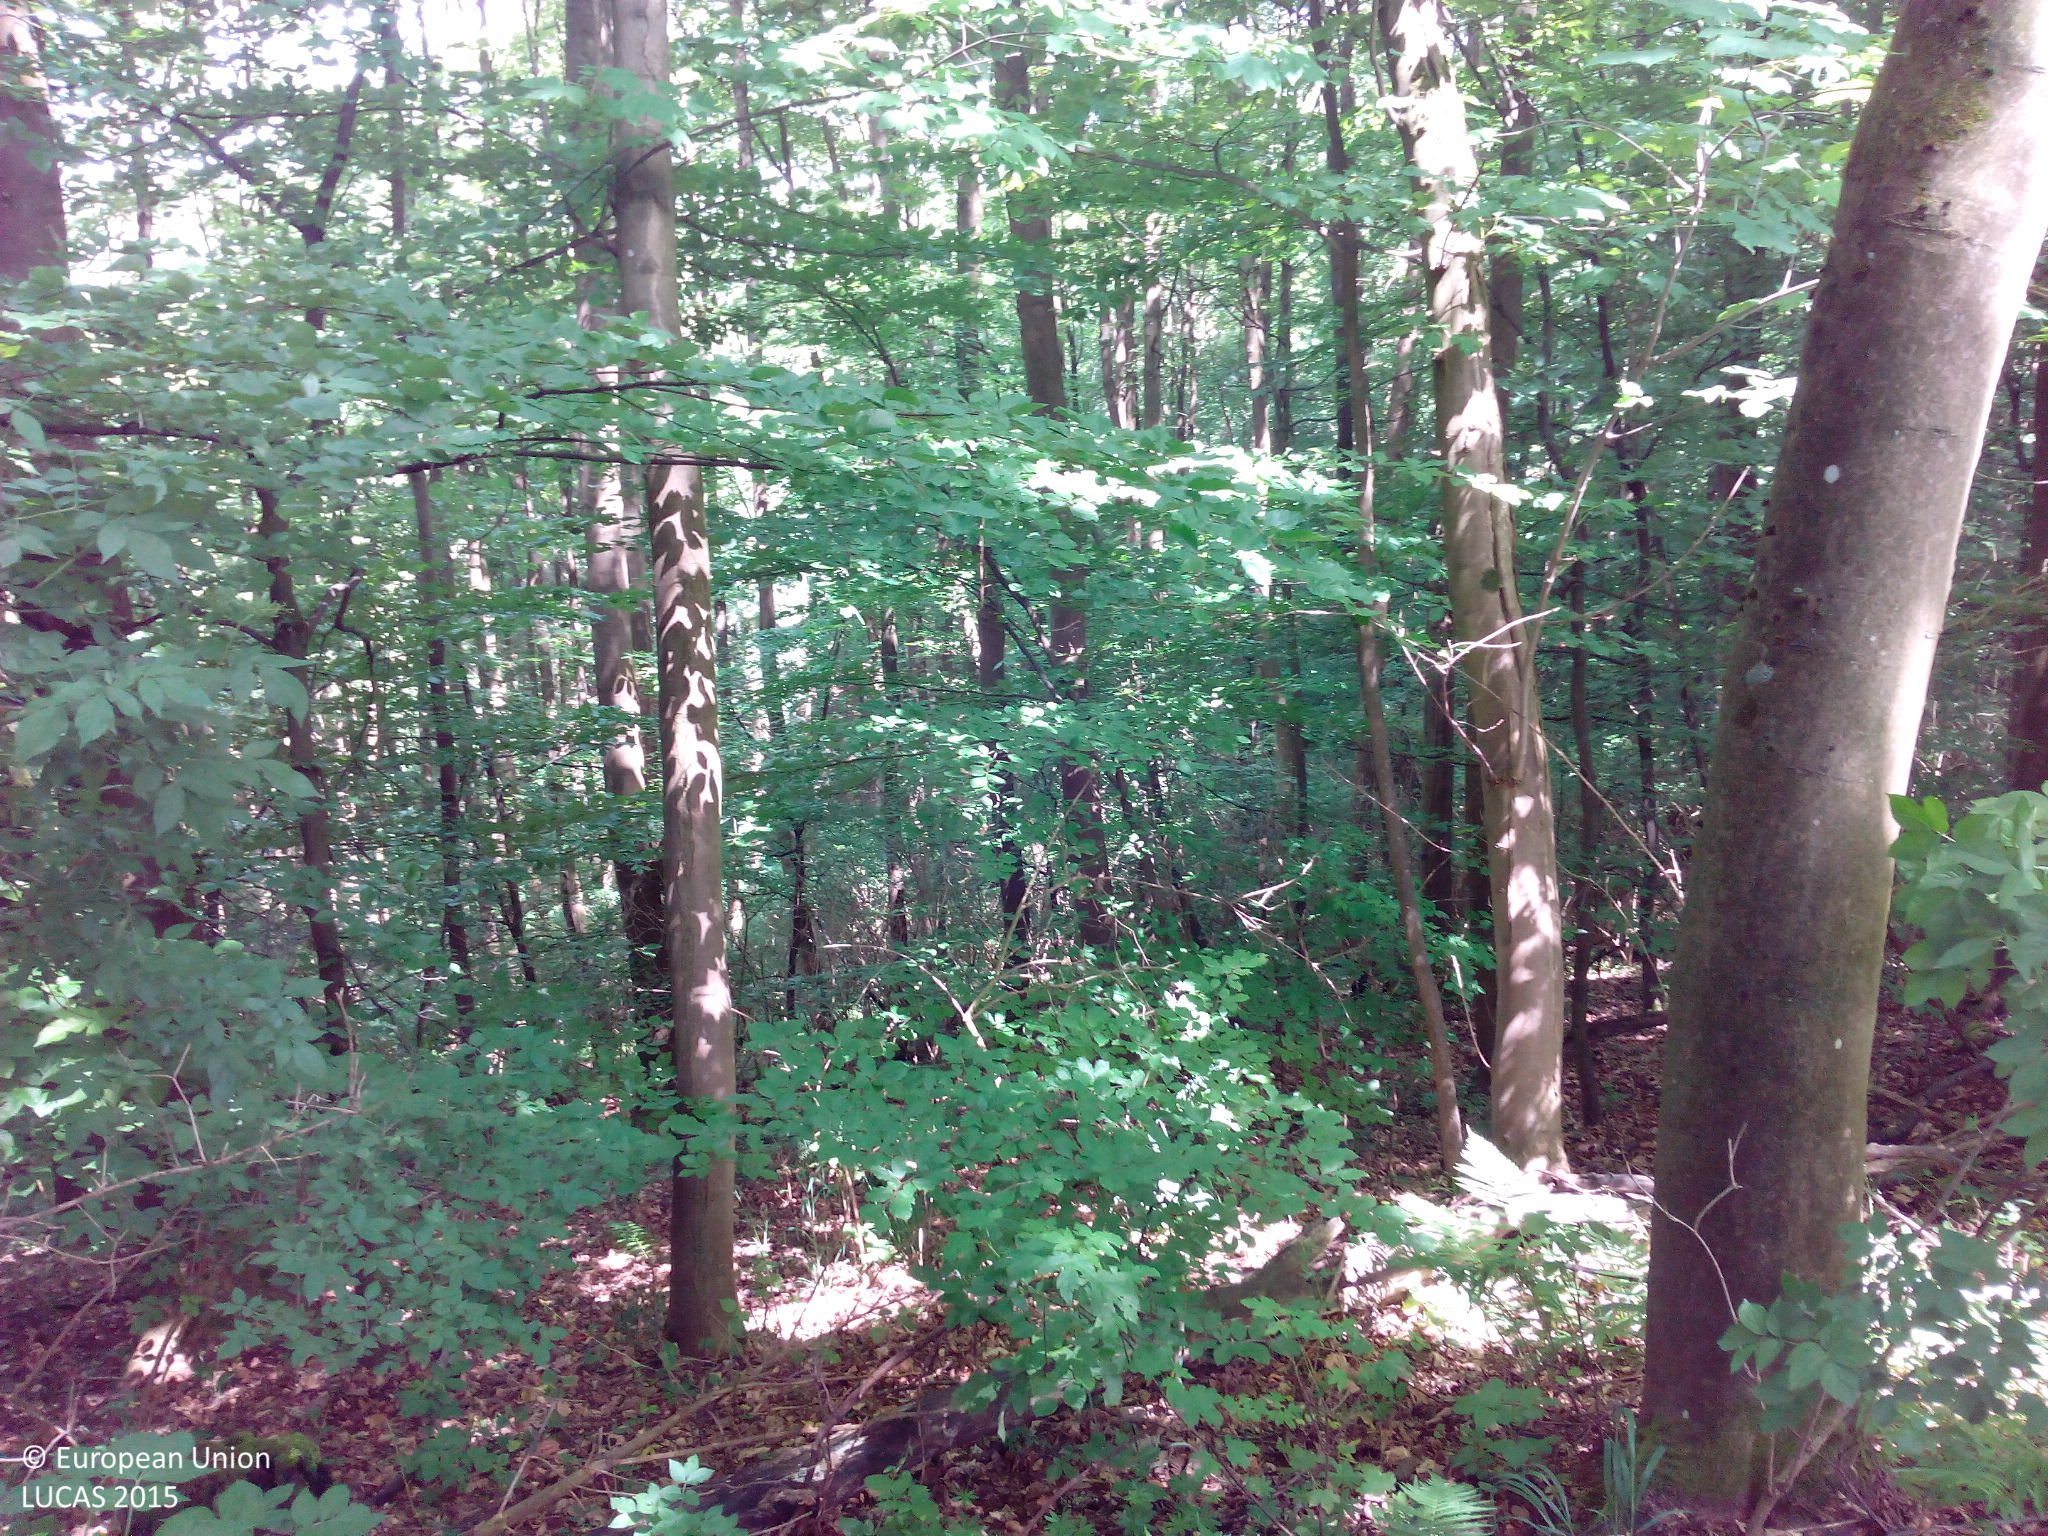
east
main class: Woodland
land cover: Broadleaved woodland
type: mesophytic deciduous forest
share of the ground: > 75 %
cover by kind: broadleaved forest trees 85 %, shrubs 10 %, coniferous forest trees 5 %
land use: Forestry
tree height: > 5 m
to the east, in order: Broadleaved woodland; Spruce dominated coniferous woodland; Grassland without tree/shrub cover; Fences; Spruce dominated coniferous woodland; Fences; Grass margins; Paved roads, cycling and walking lanes; Grassland without tree/shrub cover; Barley
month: June
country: DE
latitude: 49.0495
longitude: 9.3846
